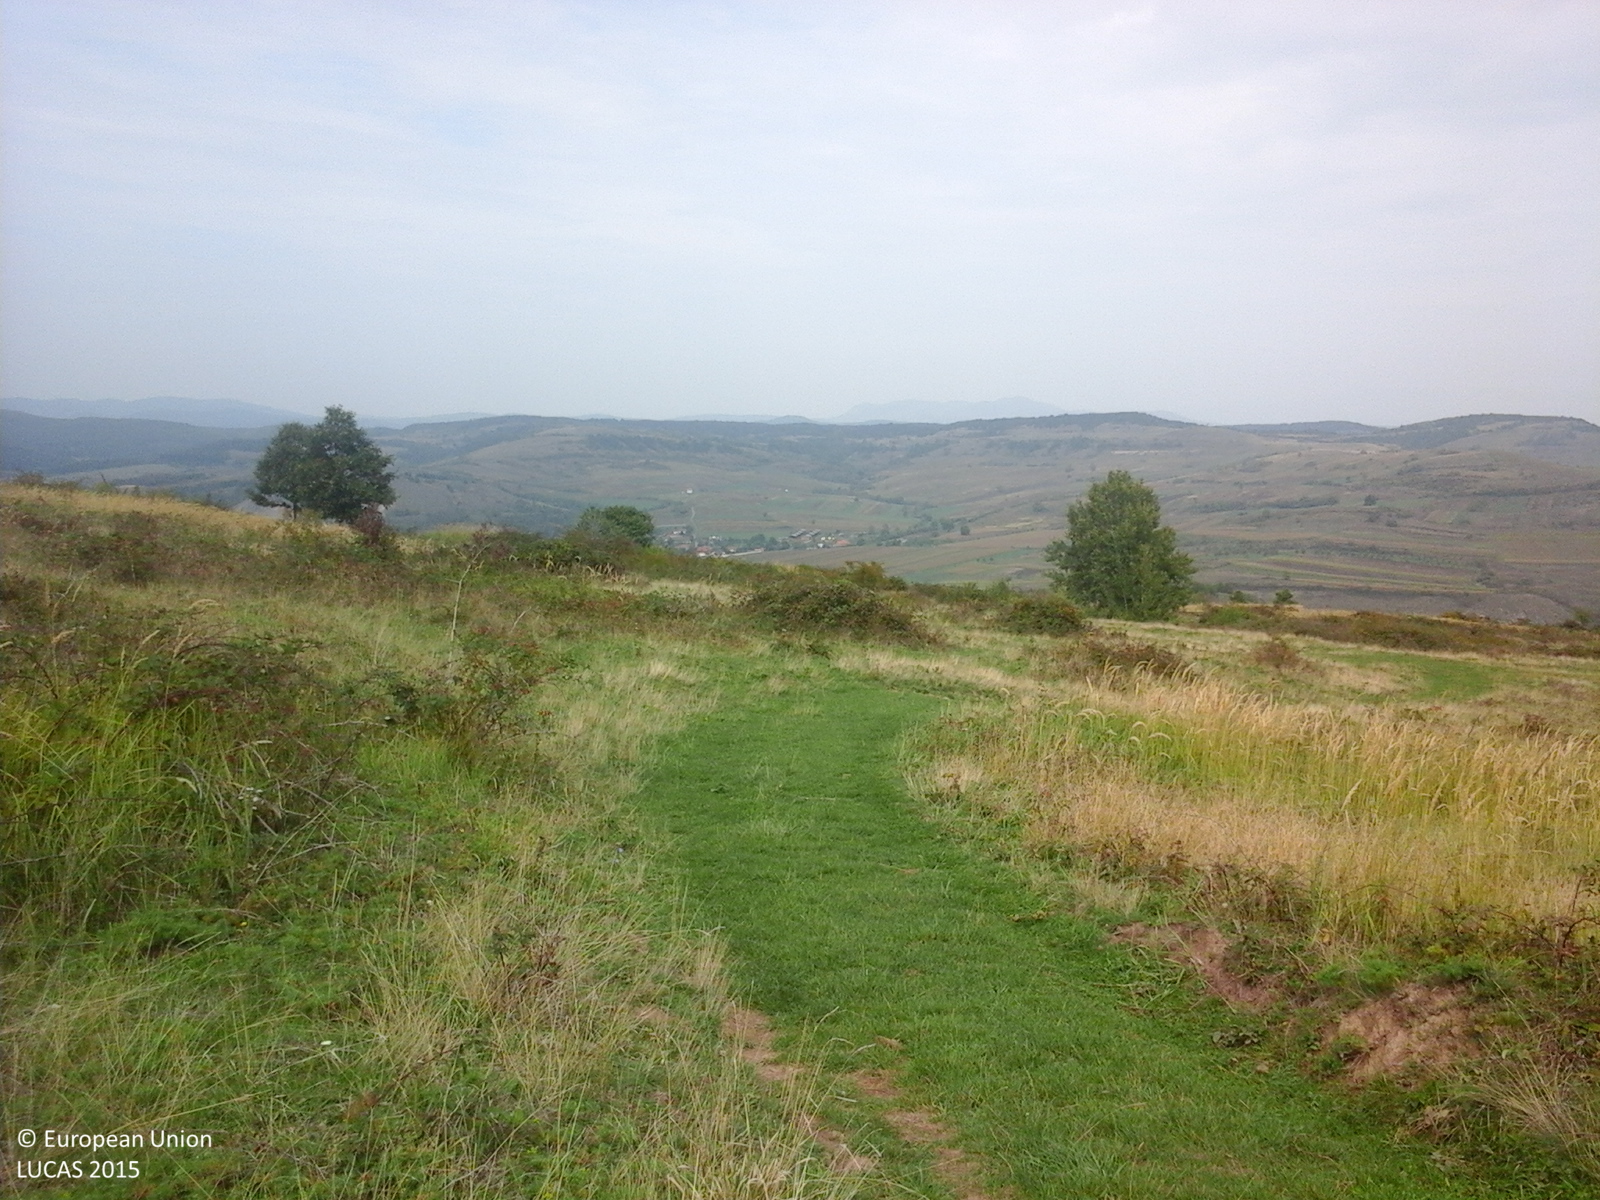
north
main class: Grassland
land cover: Grassland with sparse tree/shrub cover
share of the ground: > 75 %
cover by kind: herbaceous plants 85 %, shrubs 10 %, broadleaved forest trees 5 %
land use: Fallow land
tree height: < 5 m
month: September
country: RO
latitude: 45.7377
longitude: 22.8395
